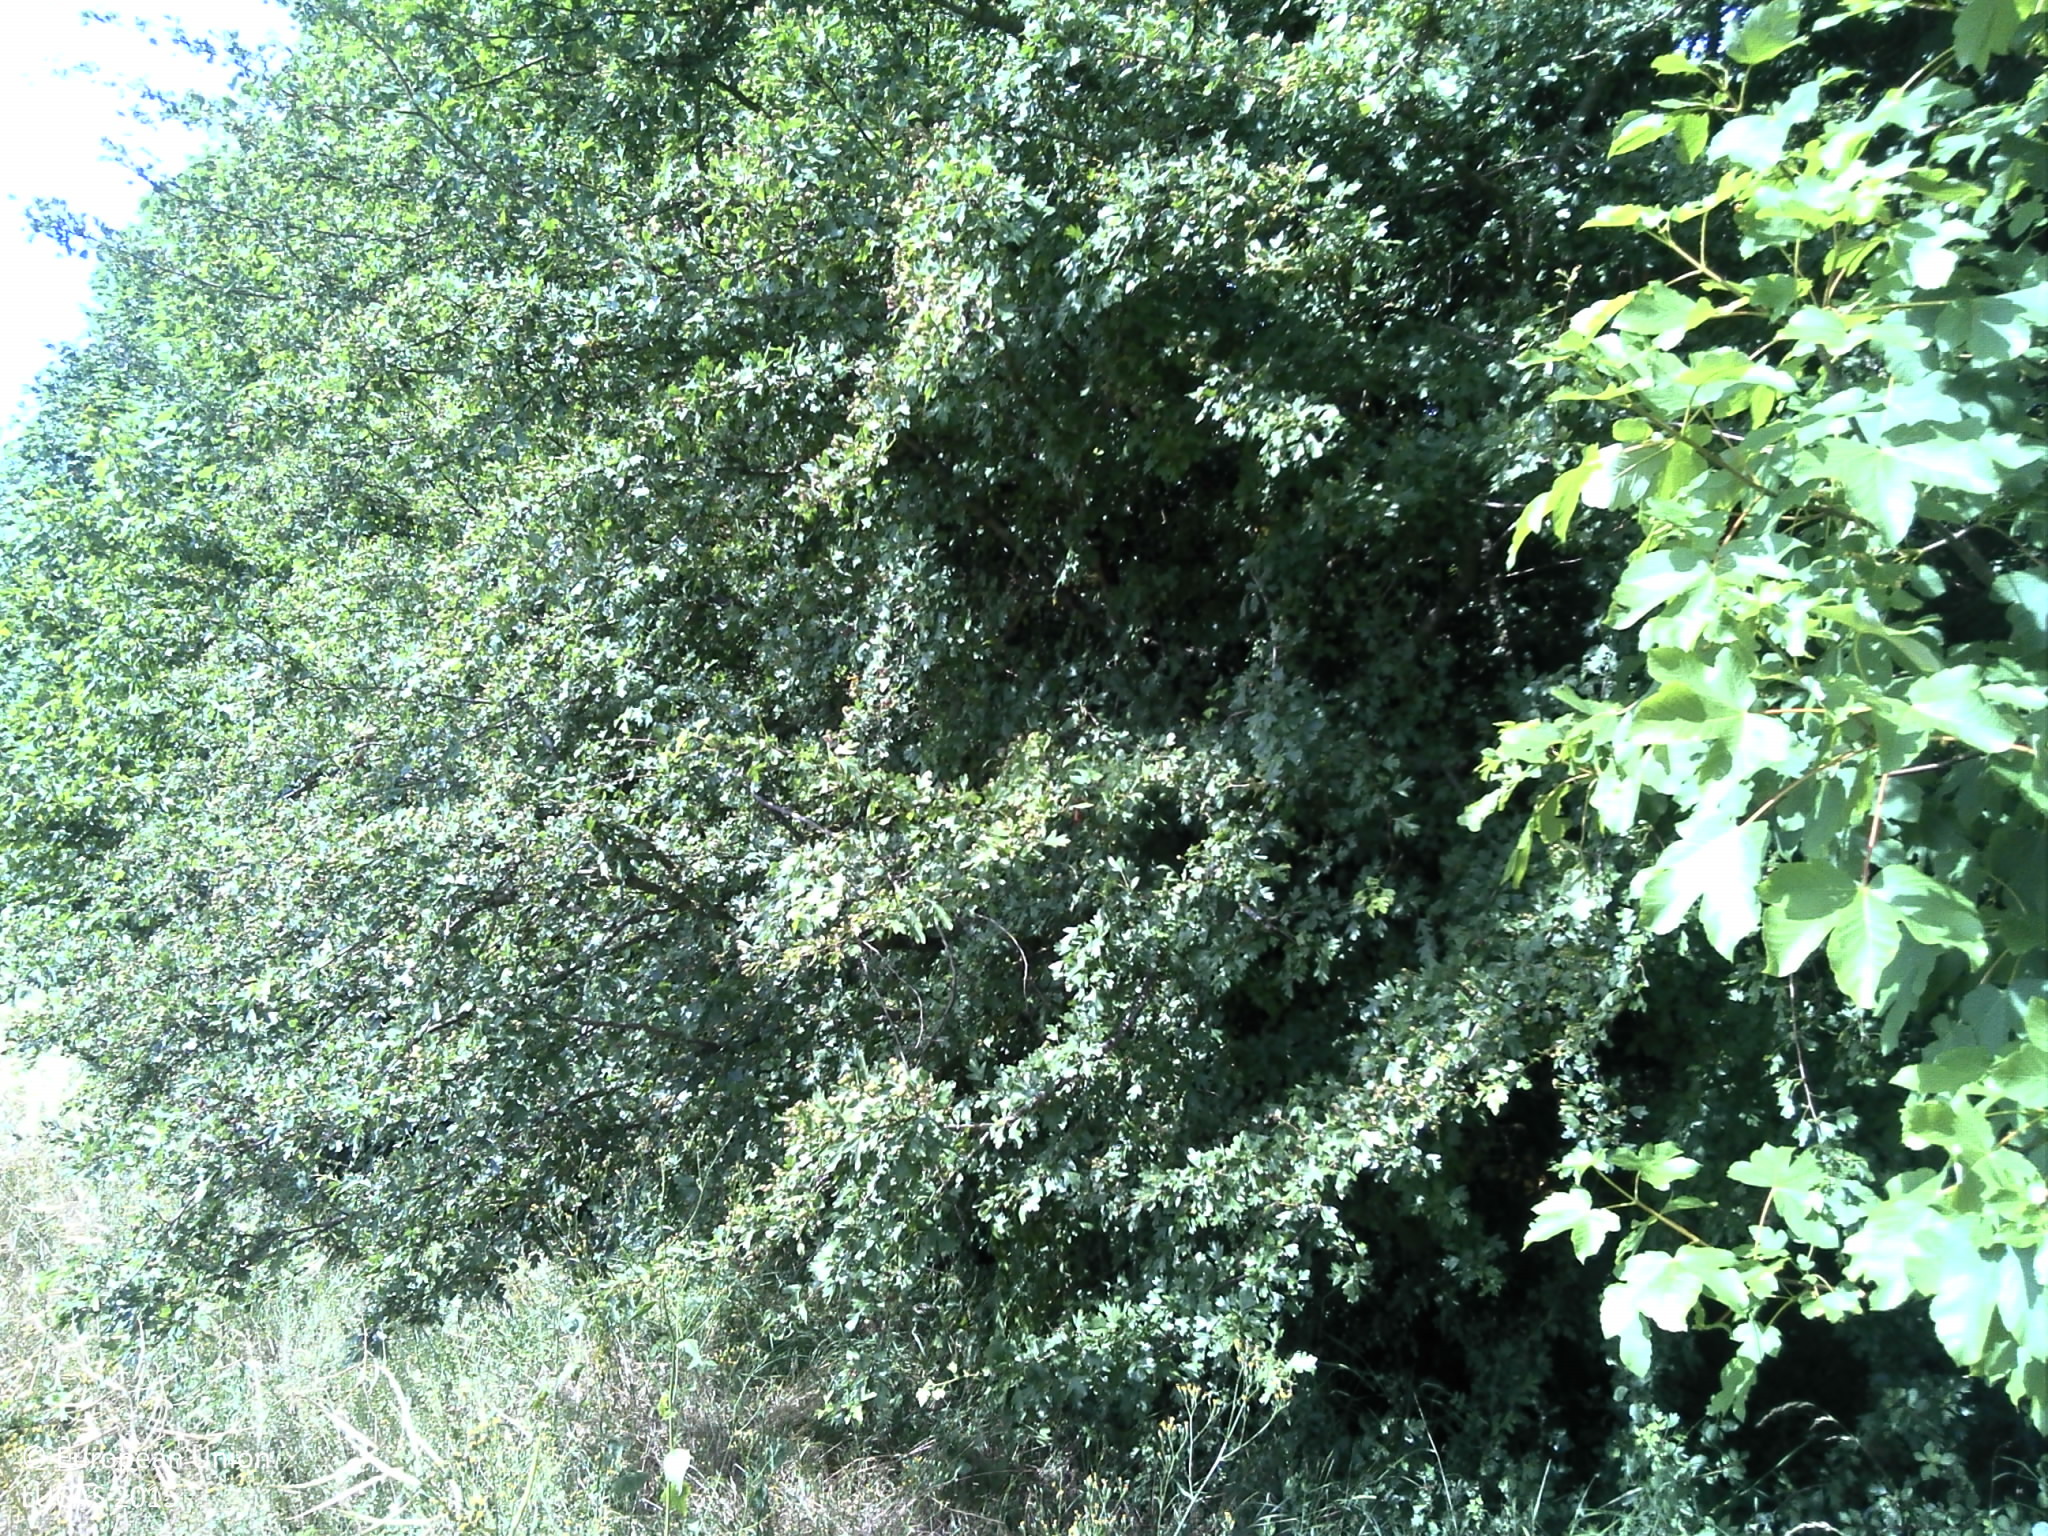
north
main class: Cropland
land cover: Rape and turnip rape
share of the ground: > 75 %
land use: Agriculture (excluding fallow land and kitchen gardens)
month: June
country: FR
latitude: 49.3227
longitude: 6.0233
